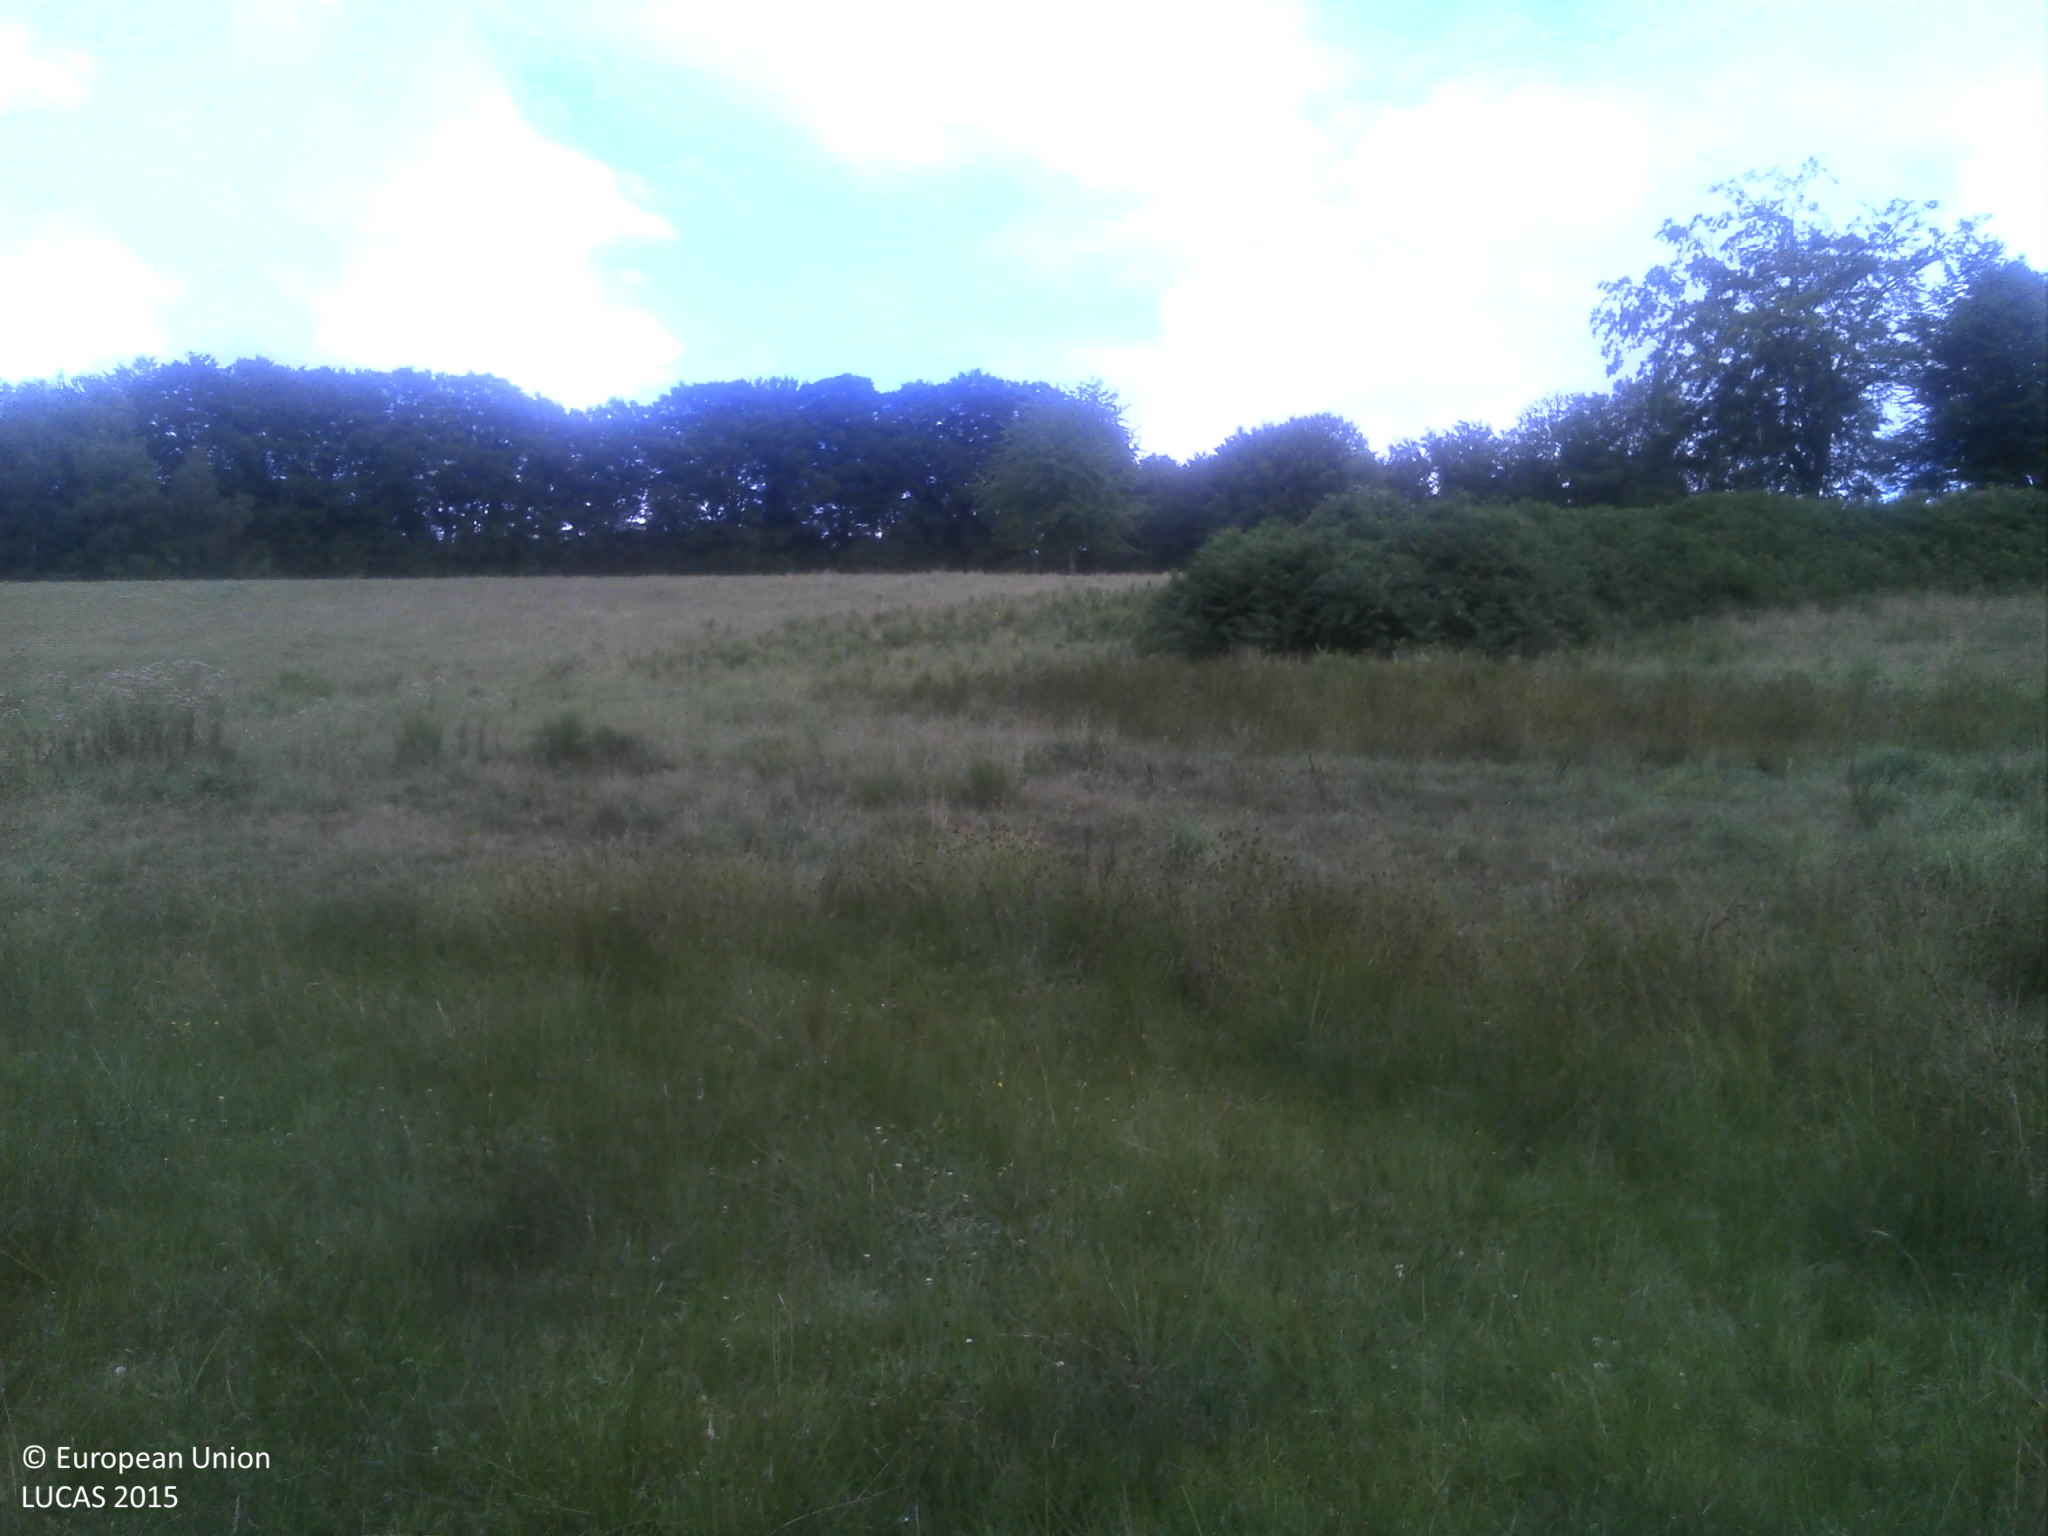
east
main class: Grassland
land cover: Grassland without tree/shrub cover
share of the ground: > 75 %
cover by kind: herbaceous plants 100 %
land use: Agriculture (excluding fallow land and kitchen gardens)
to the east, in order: Grassland without tree/shrub cover; Single bushes/trees; Dry stone walls; Fences; Lines of trees; Tracks; Dry stone walls; Broadleaved woodland
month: August
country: FR
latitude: 45.4412
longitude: 2.3146
